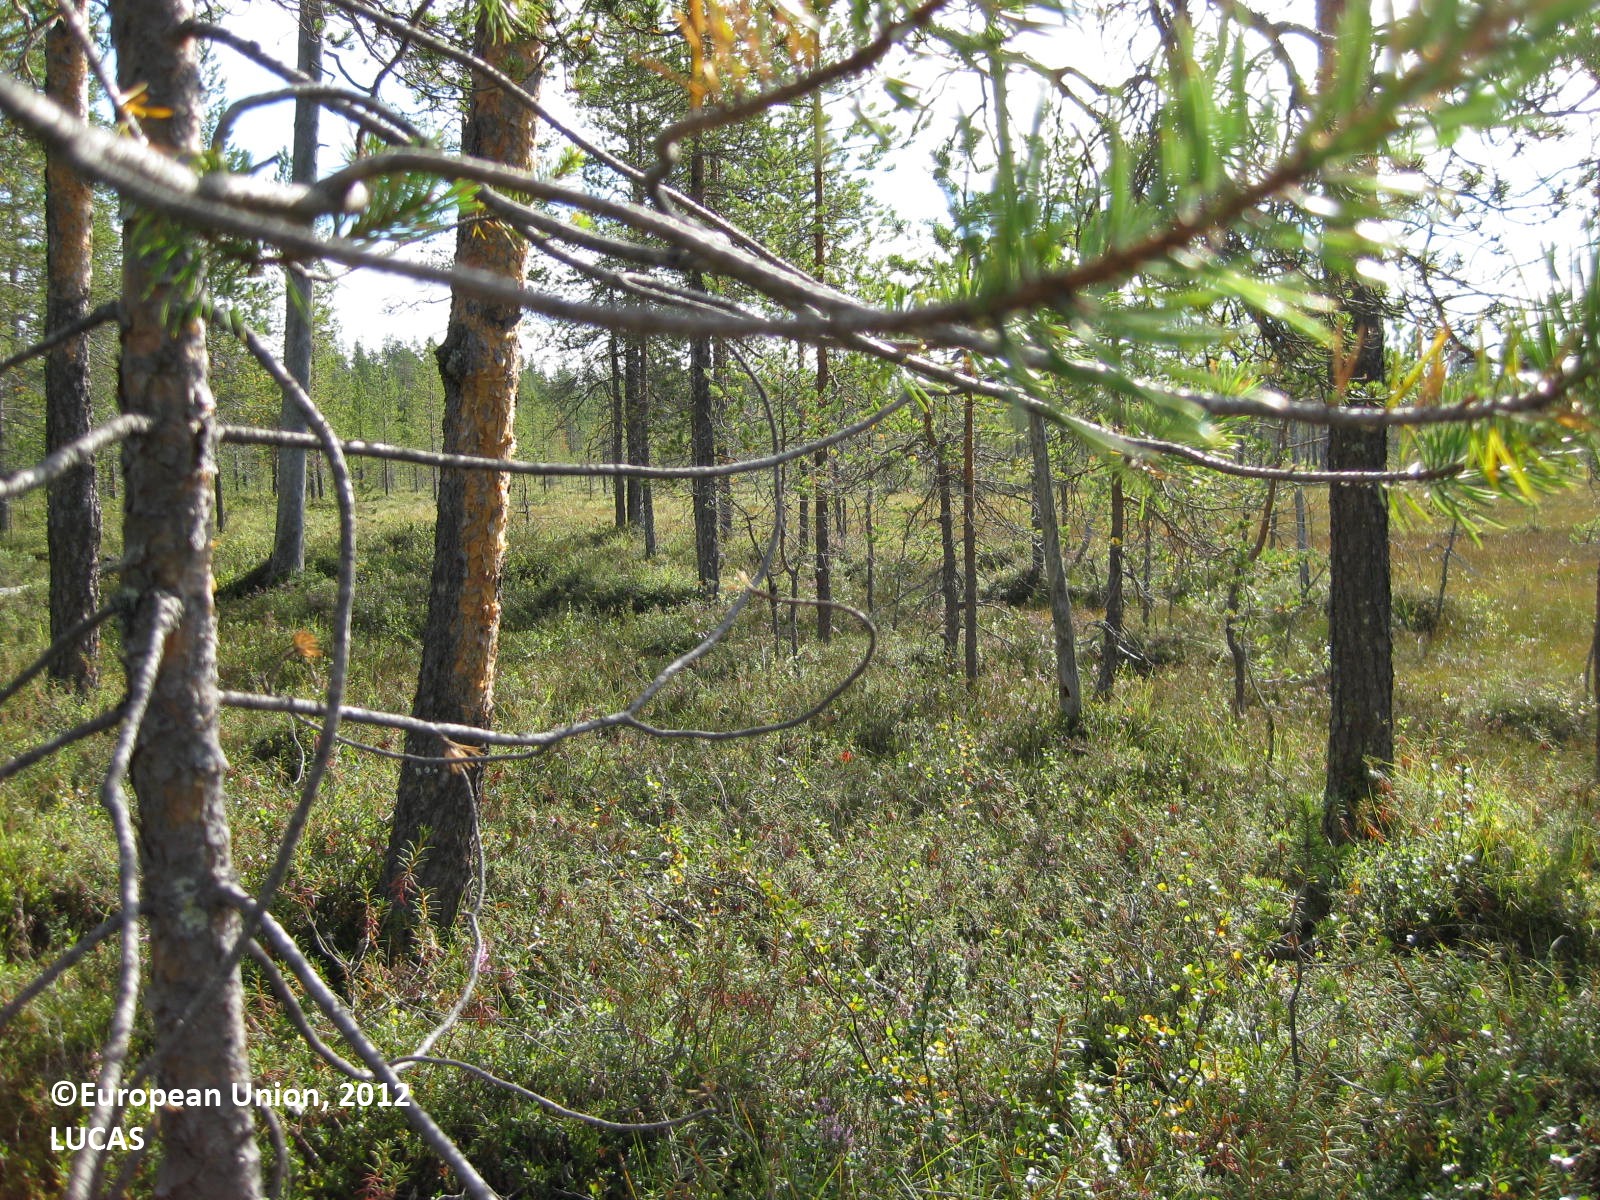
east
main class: Woodland
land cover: Pine dominated coniferous woodland
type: boreal forest
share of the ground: 50 - 75 %
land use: Forestry
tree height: > 5 m
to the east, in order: Pine dominated coniferous woodland; Peatbogs; Pine dominated coniferous woodland; Pine dominated mixed woodland; Ditches and canals; Pine dominated mixed woodland; Ditches and canals; Pine dominated coniferous woodland; Ditches and canals; Pine dominated coniferous woodland; Ditches and canals; Pine dominated coniferous woodland
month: August
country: FI
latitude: 66.5432
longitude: 29.0528
